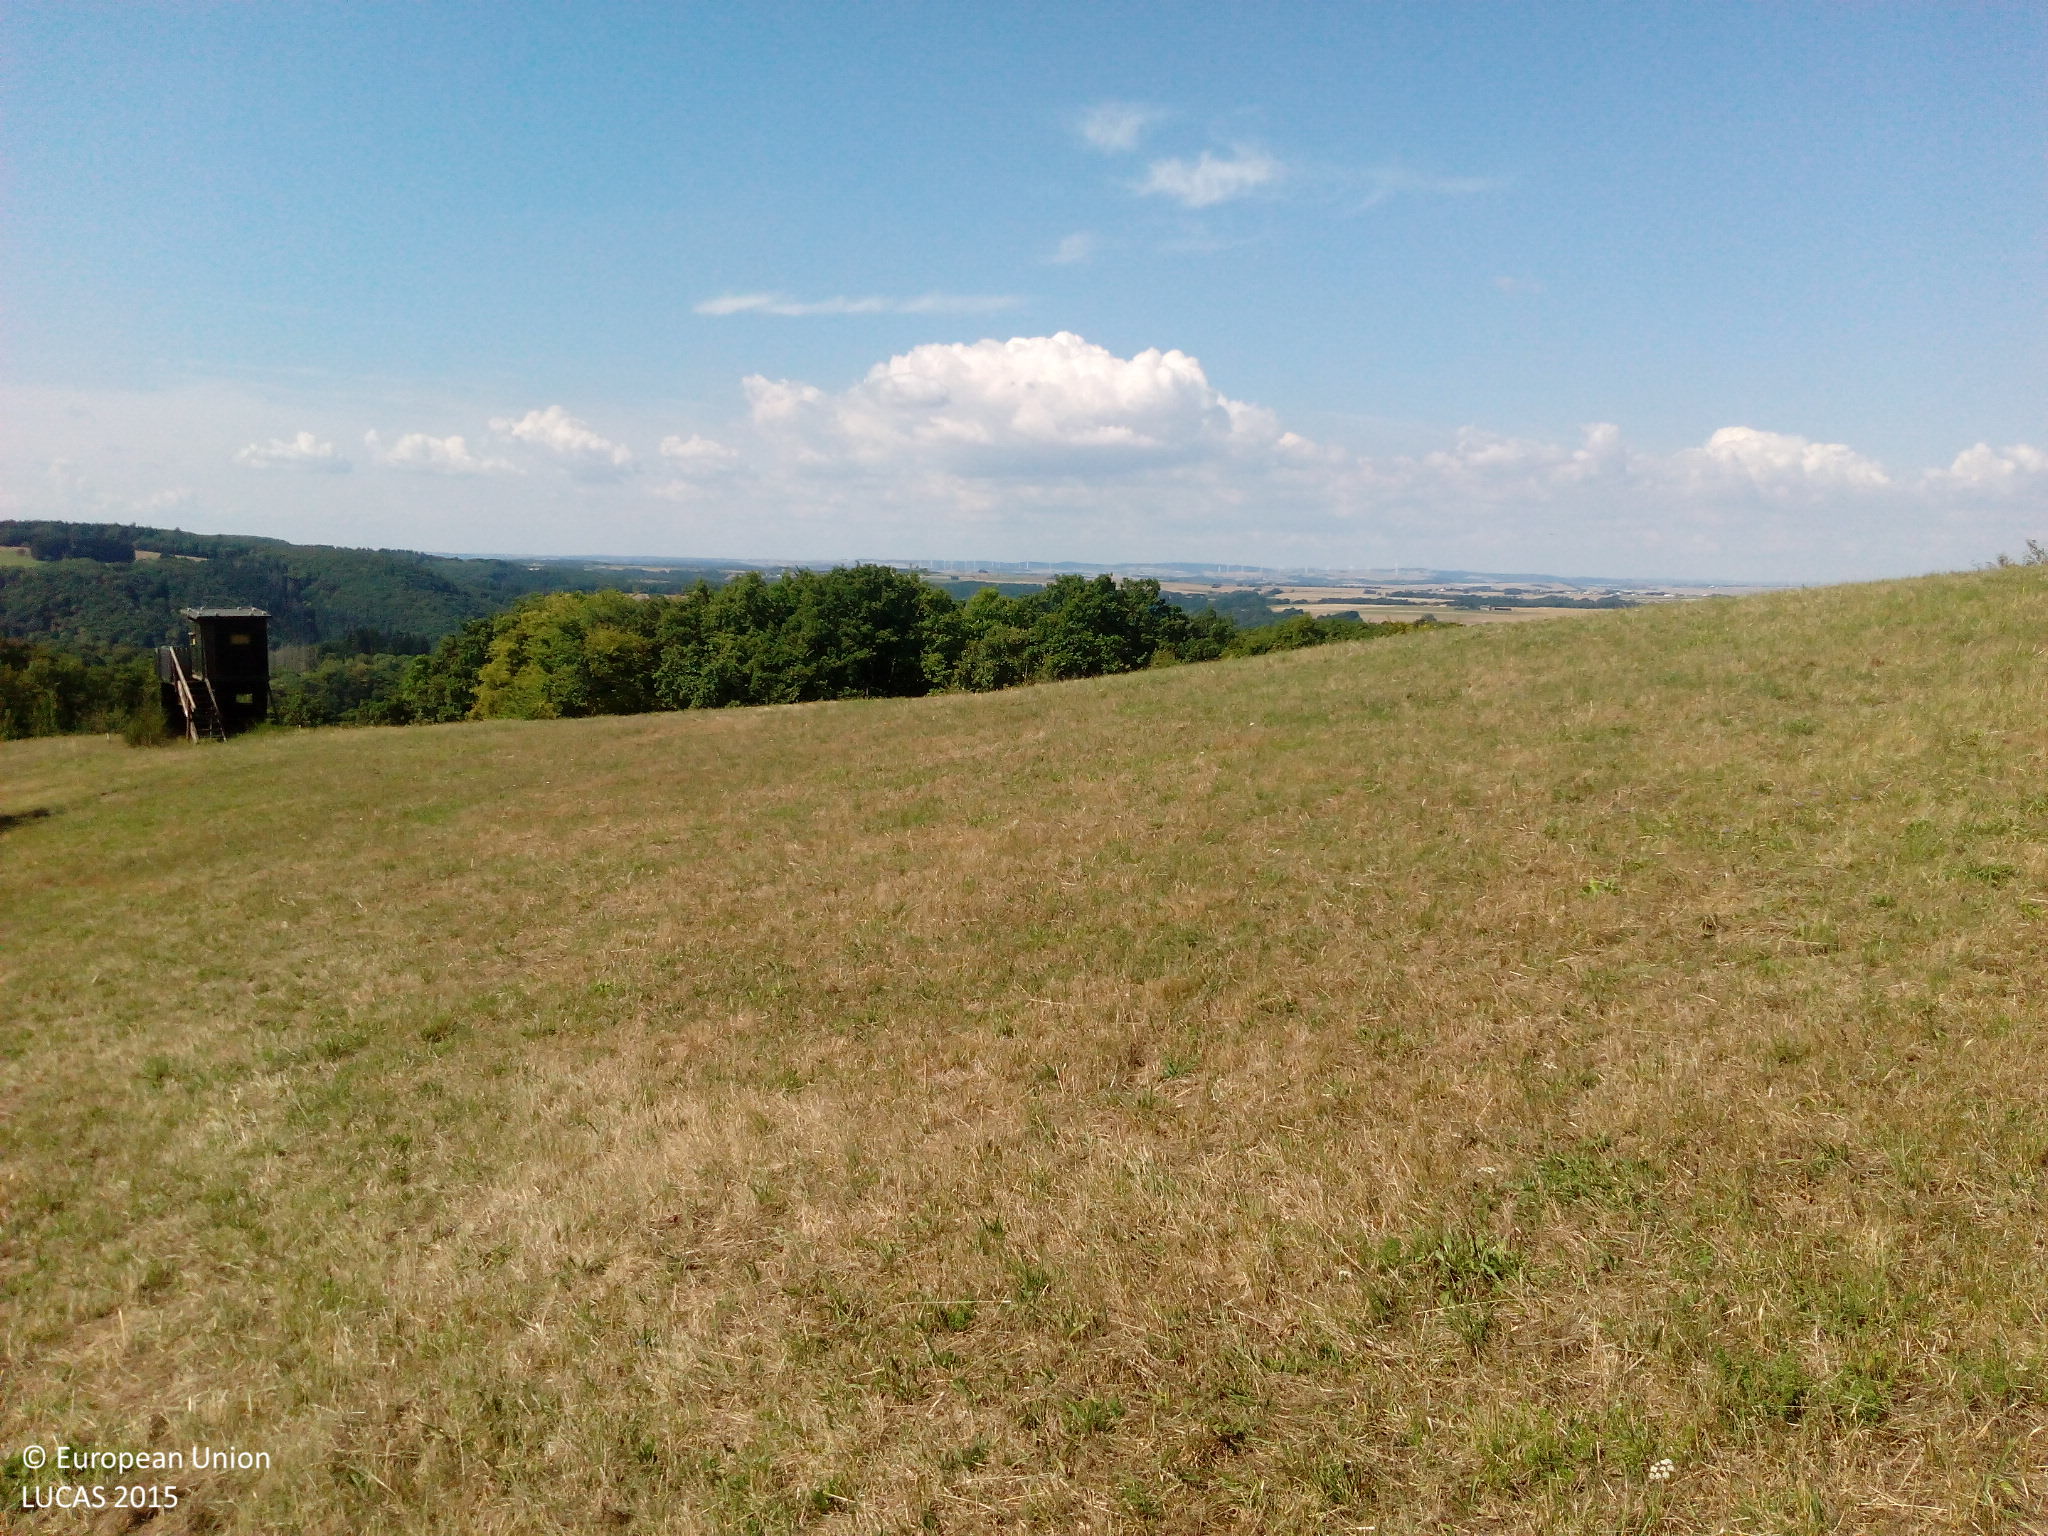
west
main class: Grassland
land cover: Grassland without tree/shrub cover
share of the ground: > 75 %
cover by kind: herbaceous plants 90 %, unconsolidated bare surface 10 %
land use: Agriculture (excluding fallow land and kitchen gardens)
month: August
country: DE
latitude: 50.2280
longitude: 7.4631
